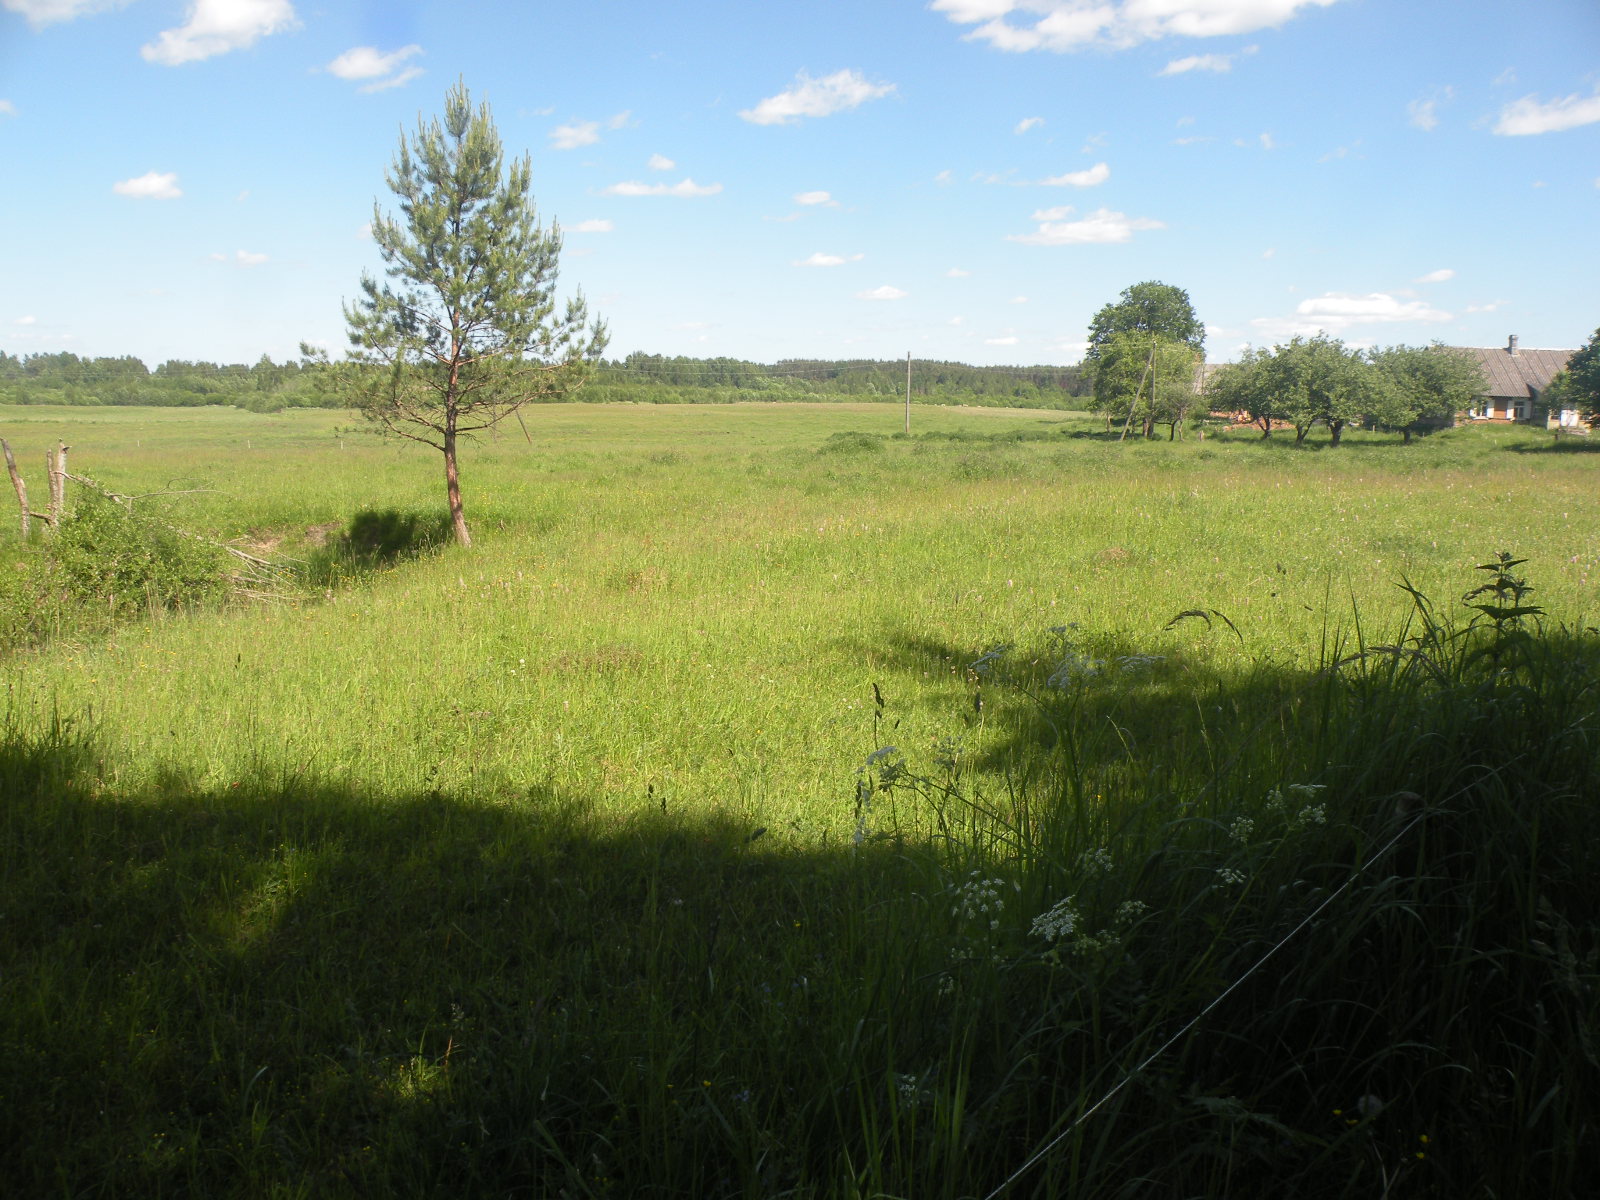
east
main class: Grassland
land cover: Grassland without tree/shrub cover
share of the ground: > 75 %
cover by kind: herbaceous plants 100 %
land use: Agriculture (excluding fallow land and kitchen gardens)
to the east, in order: Grassland without tree/shrub cover; Ditches and canals; Grassland without tree/shrub cover
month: June
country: LV
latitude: 55.9311
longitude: 26.9548
